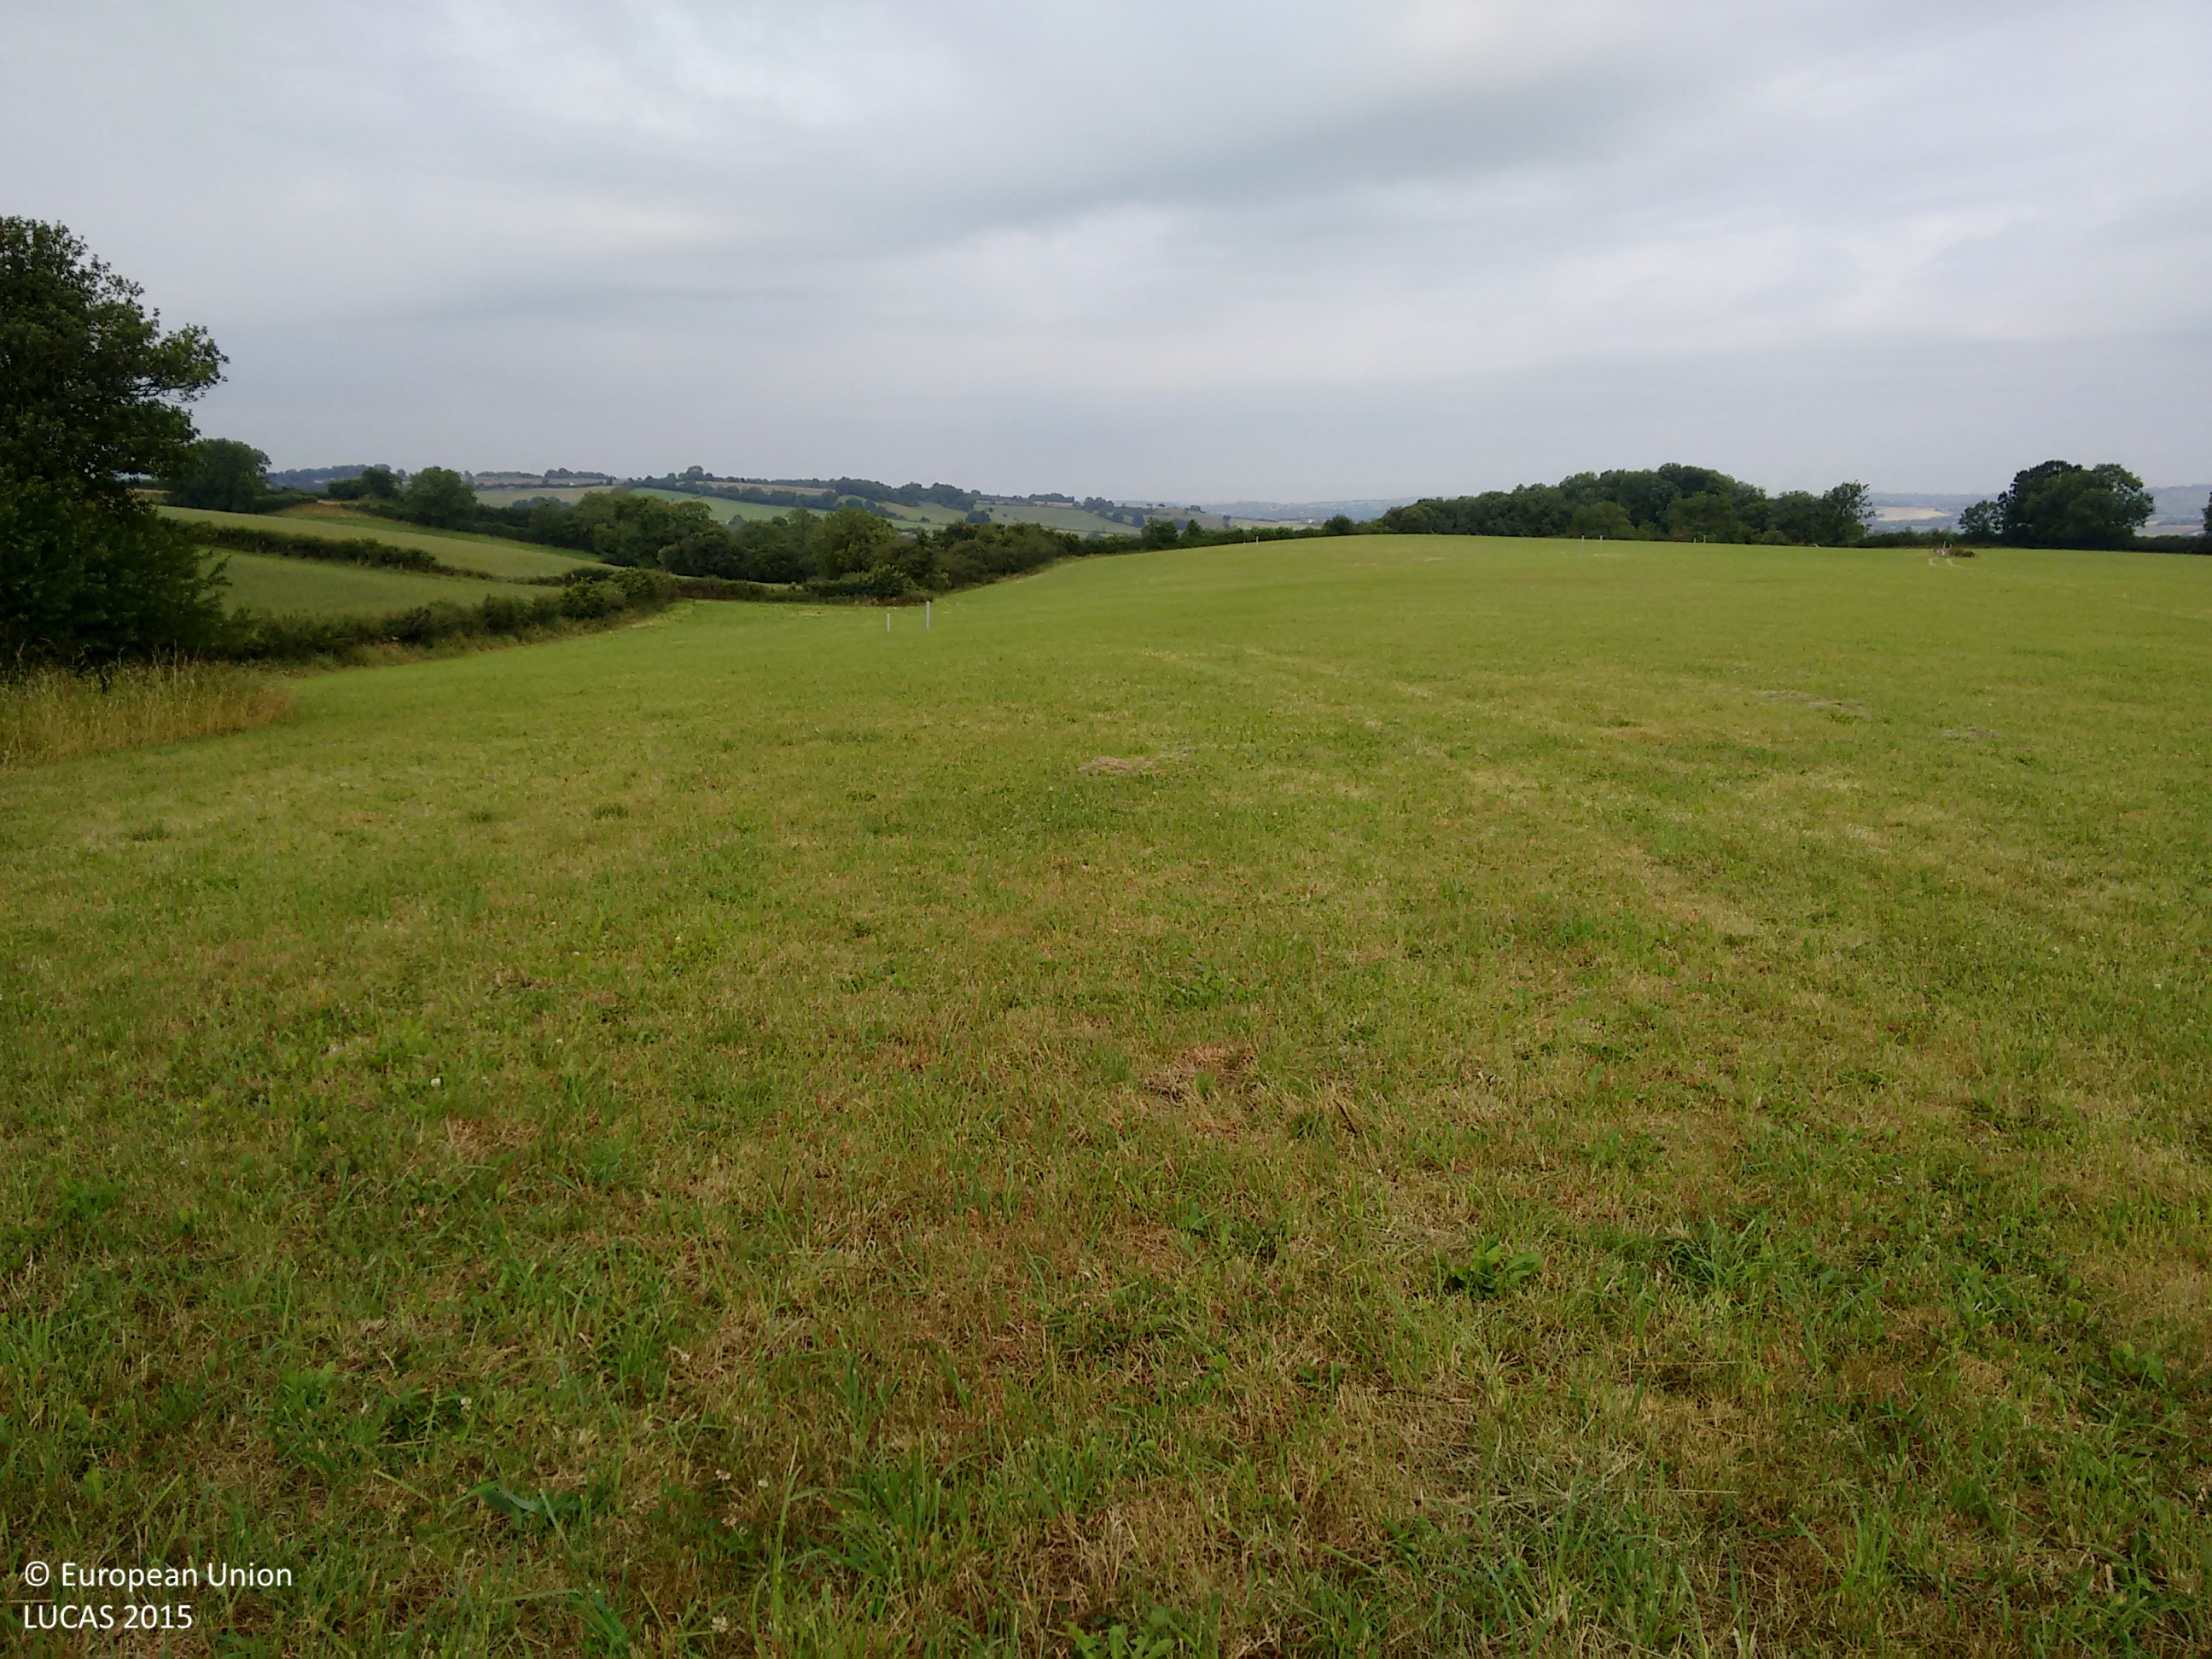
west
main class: Grassland
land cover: Grassland without tree/shrub cover
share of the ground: > 75 %
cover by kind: herbaceous plants 100 %
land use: Agriculture (excluding fallow land and kitchen gardens)
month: July
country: GB
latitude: 51.3479
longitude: -2.5147
